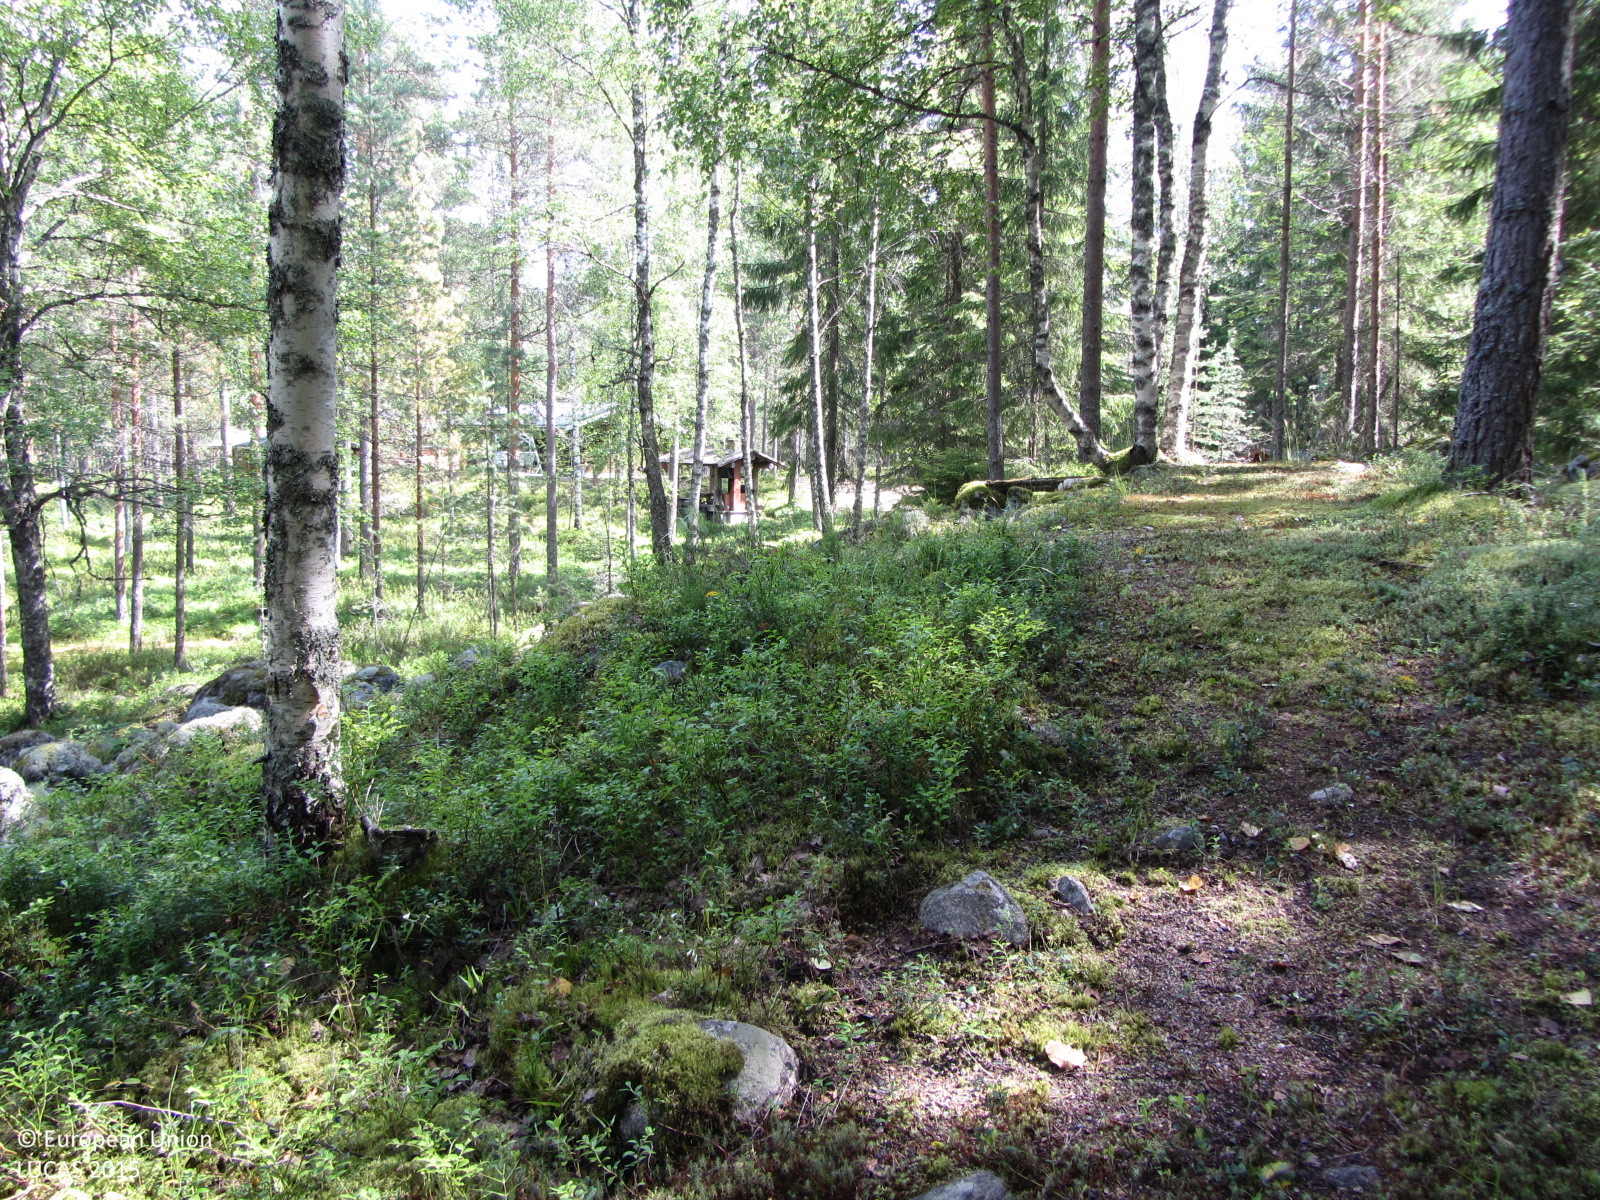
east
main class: Woodland
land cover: Pine dominated mixed woodland
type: boreal forest
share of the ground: 50 - 75 %
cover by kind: coniferous forest trees 30 %, broadleaved forest trees 30 %, shrubs 20 %, lichens and mosses 15 %, unconsolidated bare surface 5 %
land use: Forestry
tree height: > 5 m
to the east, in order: Pine dominated mixed woodland; Artificial constructions in urban areas; Pine dominated mixed woodland; Artificial constructions in urban areas; Pine dominated mixed woodland; Tracks; Pine dominated mixed woodland
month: July
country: FI
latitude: 60.6311
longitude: 24.3790
